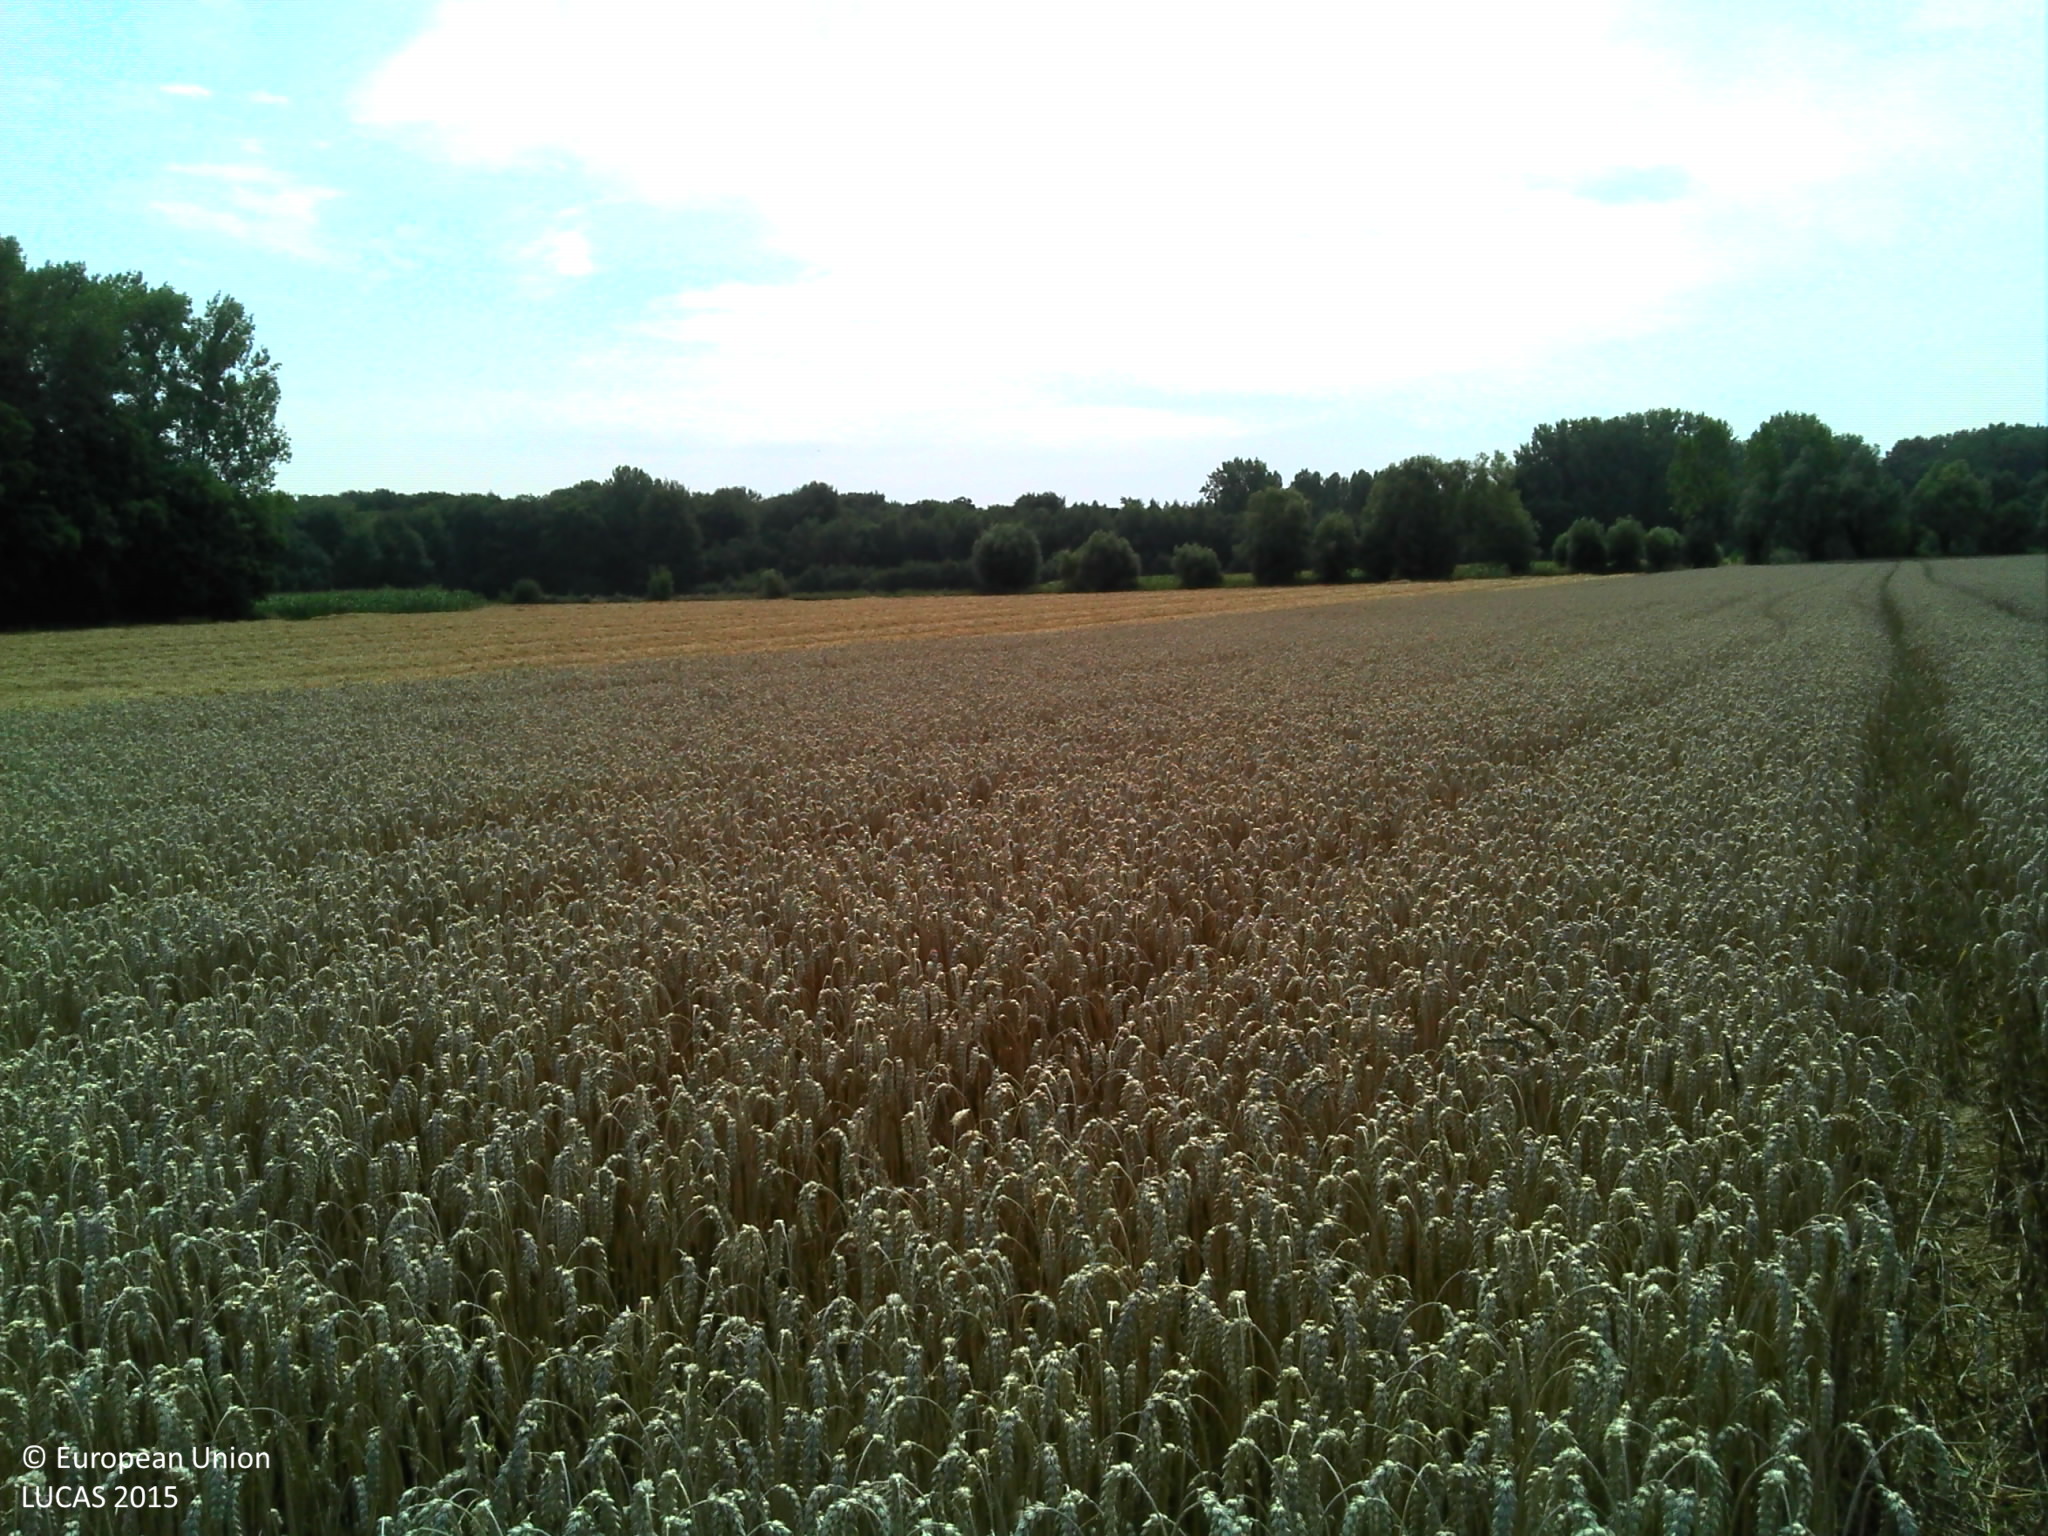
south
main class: Cropland
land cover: Common wheat
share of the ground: > 75 %
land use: Agriculture (excluding fallow land and kitchen gardens)
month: August
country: BE
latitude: 50.7236
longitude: 3.8884
